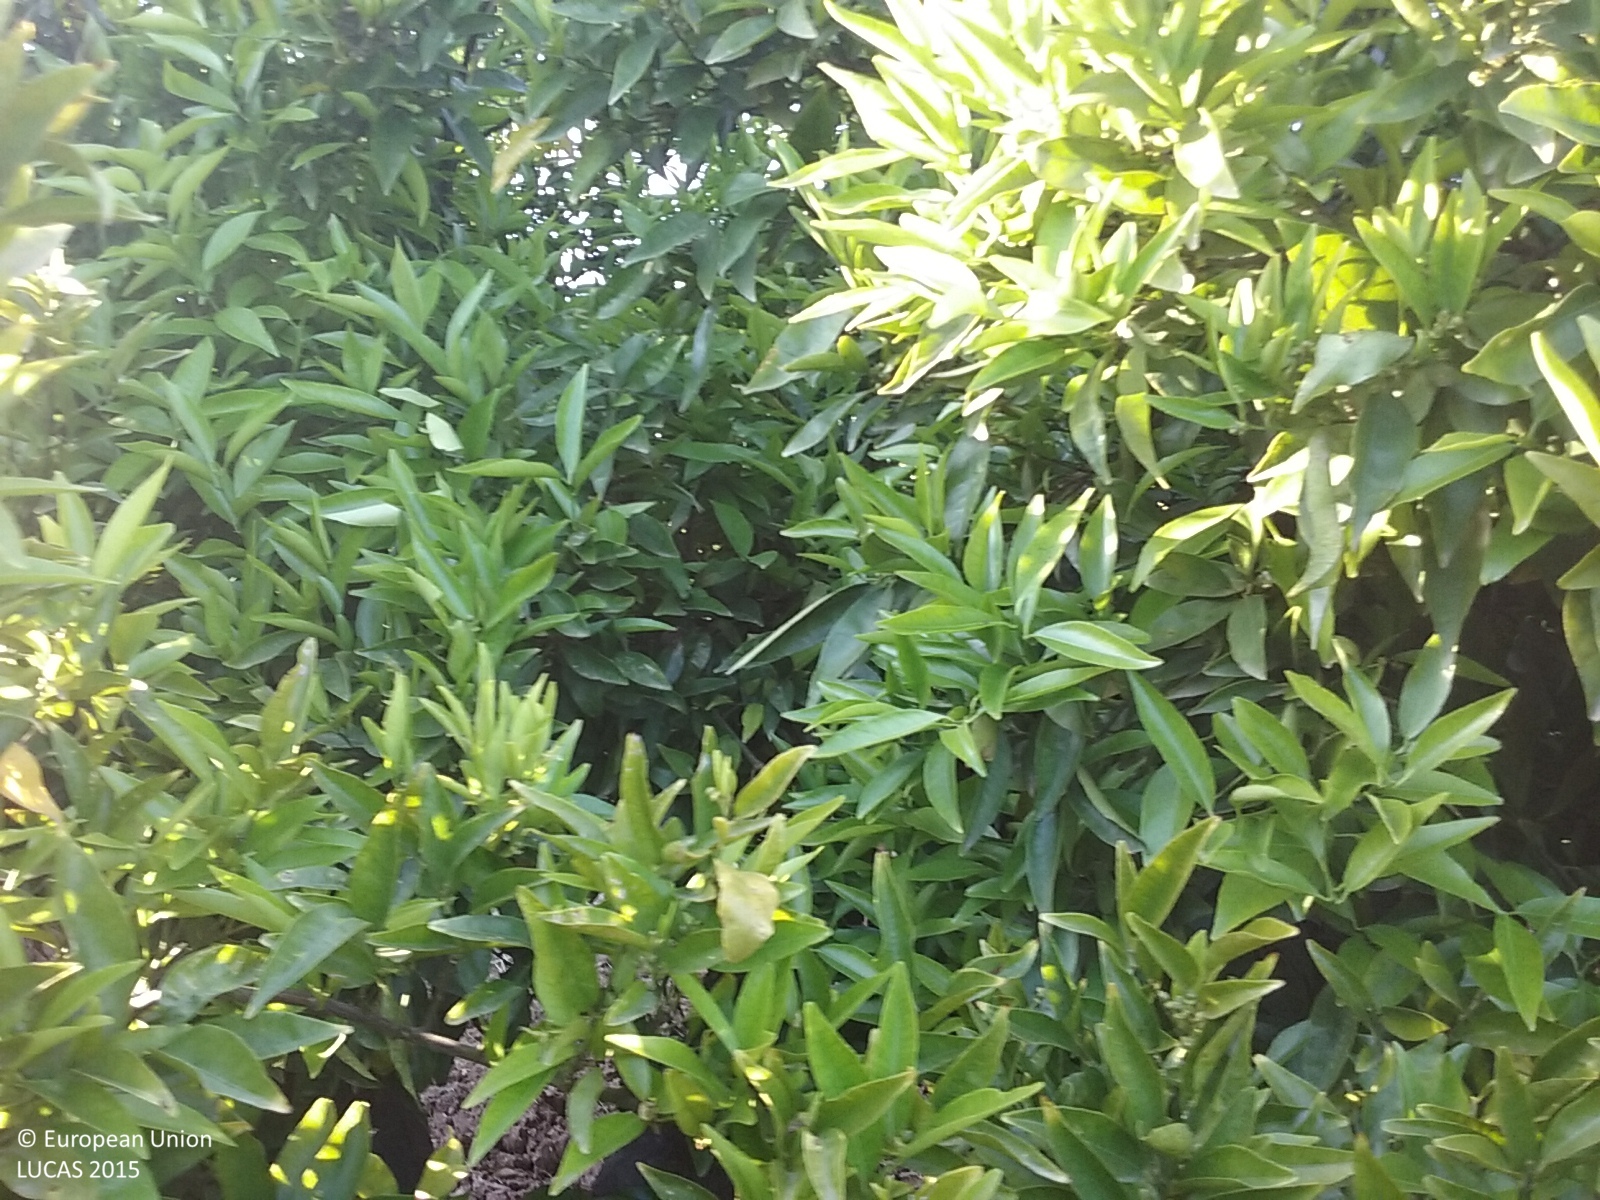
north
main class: Cropland
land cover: Other citrus fruit
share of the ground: 50 - 75 %
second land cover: Other bare soil
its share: > 75 %
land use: Agriculture (excluding fallow land and kitchen gardens)
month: May
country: ES
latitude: 39.9343
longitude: -0.0291
